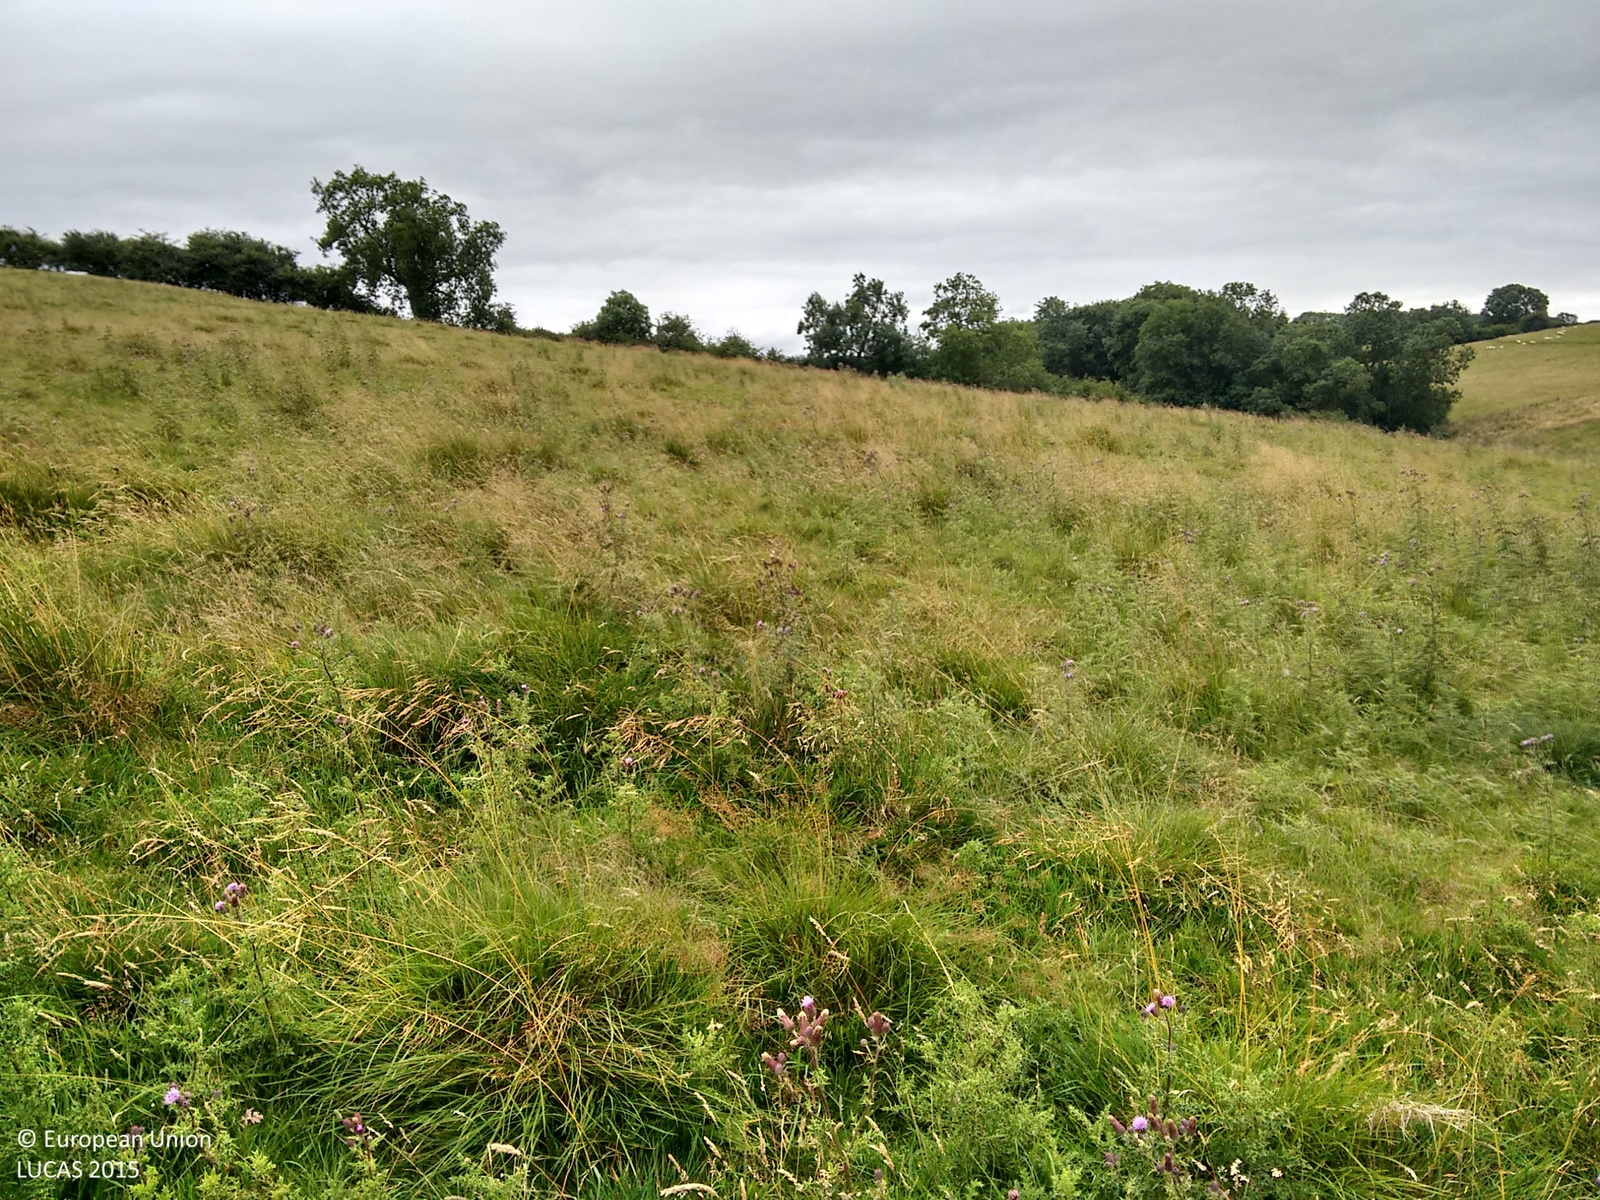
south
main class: Grassland
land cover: Grassland without tree/shrub cover
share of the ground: > 75 %
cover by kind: herbaceous plants 100 %
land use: Agriculture (excluding fallow land and kitchen gardens)
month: July
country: GB
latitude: 52.8105
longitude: -0.9776
